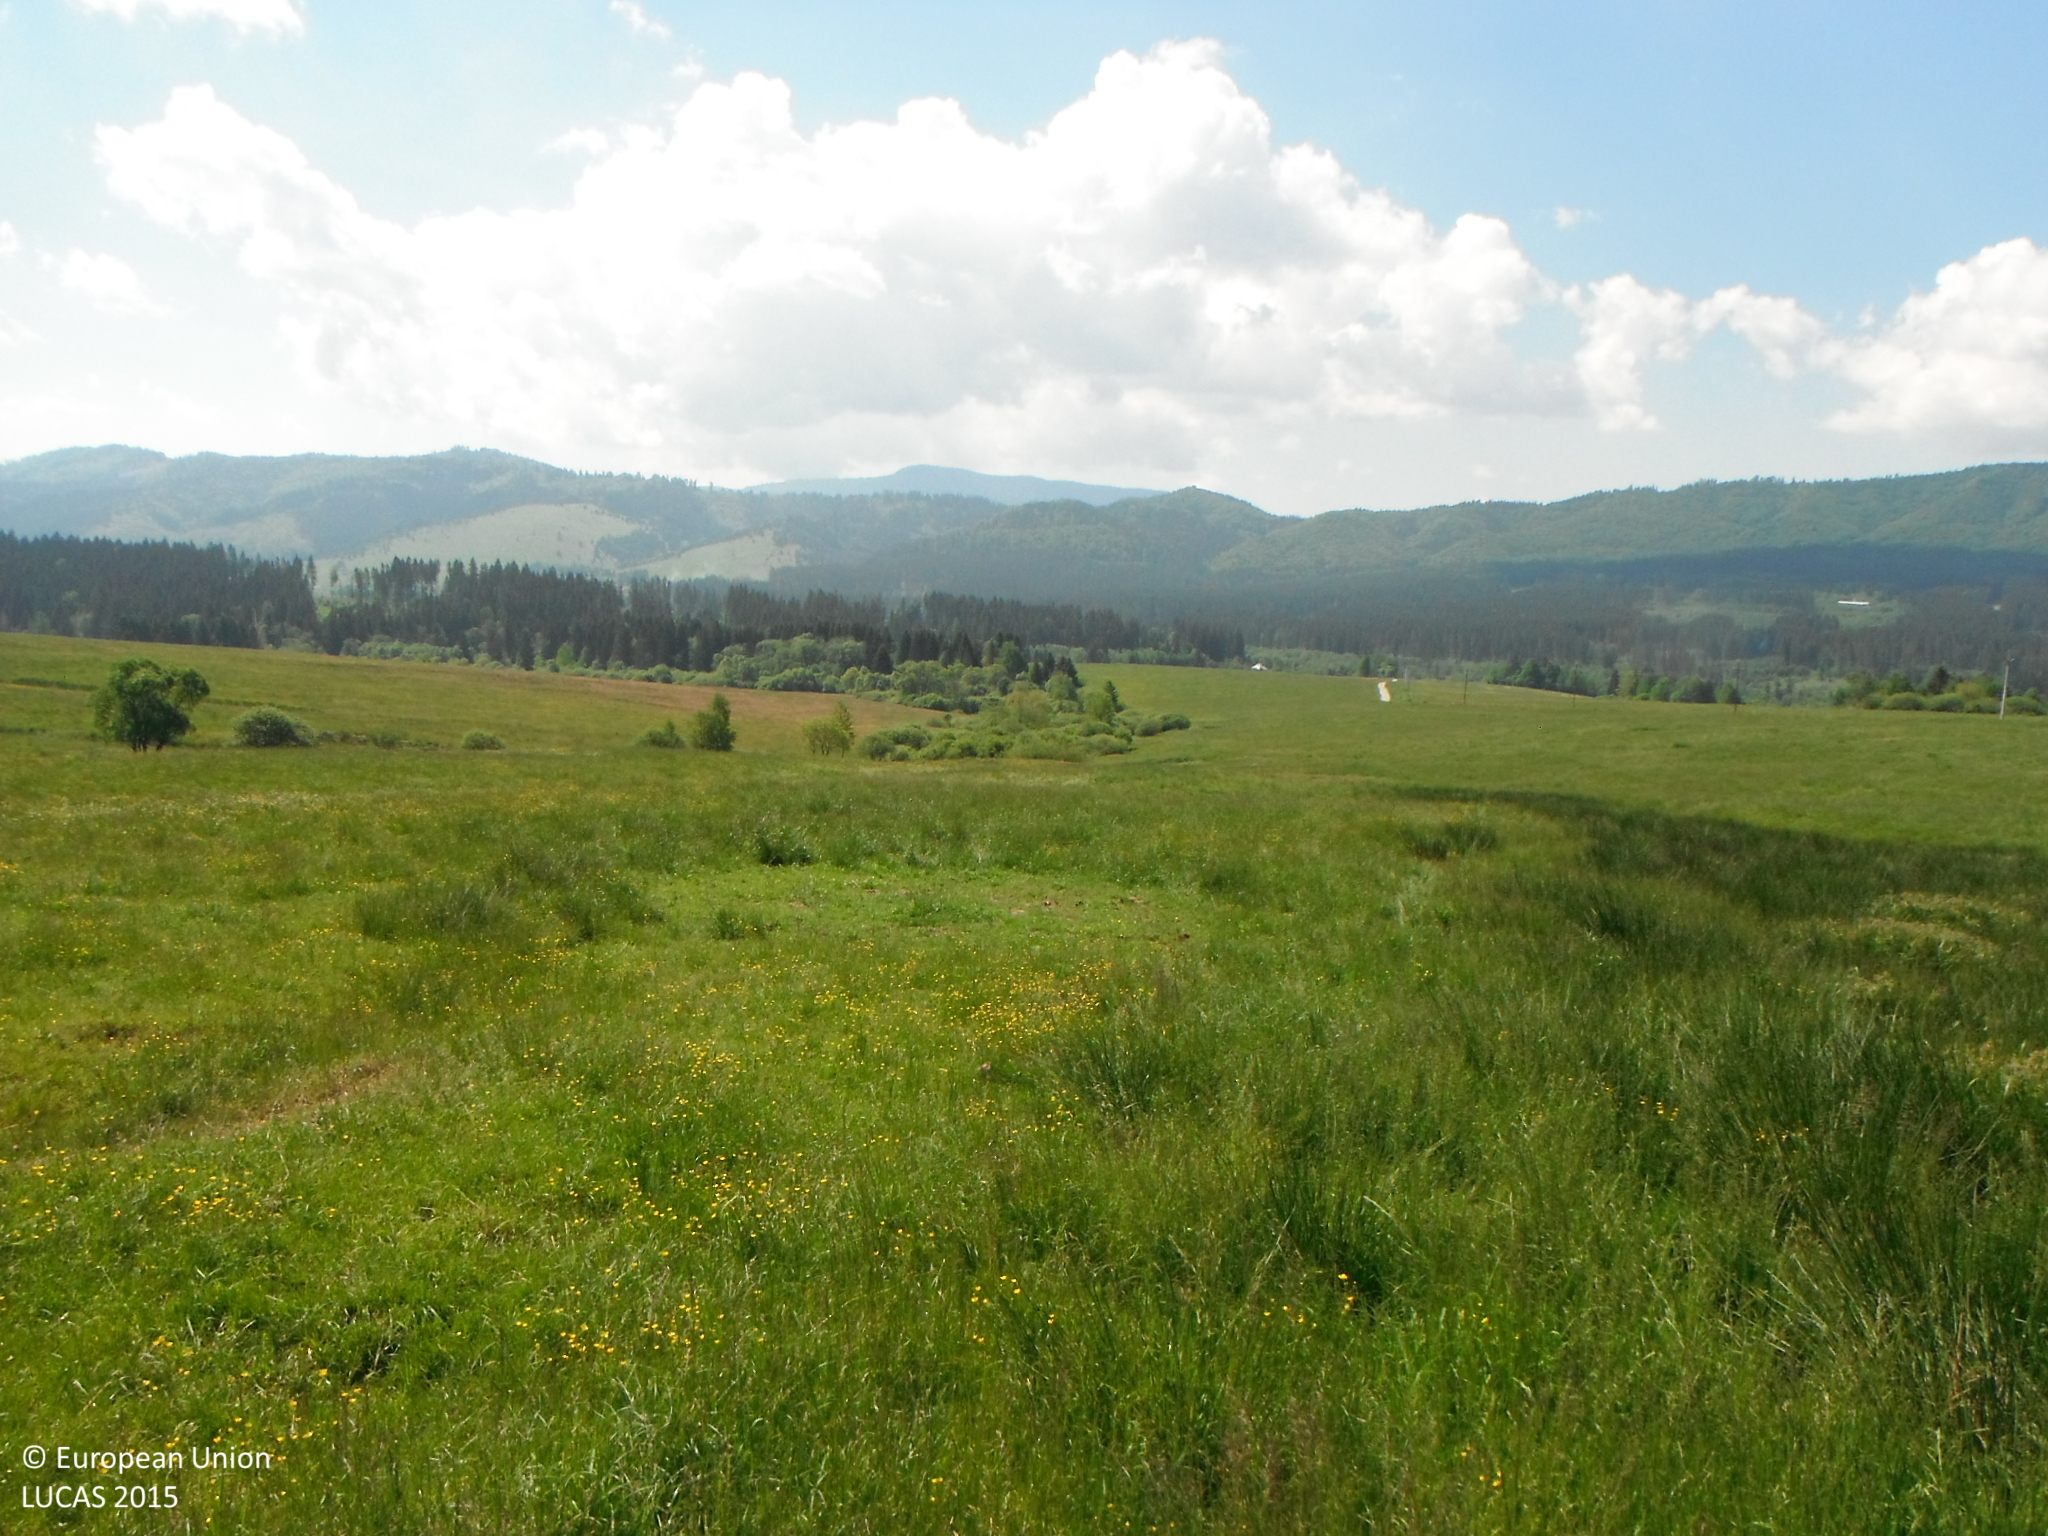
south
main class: Grassland
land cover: Grassland without tree/shrub cover
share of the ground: > 75 %
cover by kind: herbaceous plants 100 %
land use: Agriculture (excluding fallow land and kitchen gardens)
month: June
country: SK
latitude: 48.7863
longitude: 19.7595
